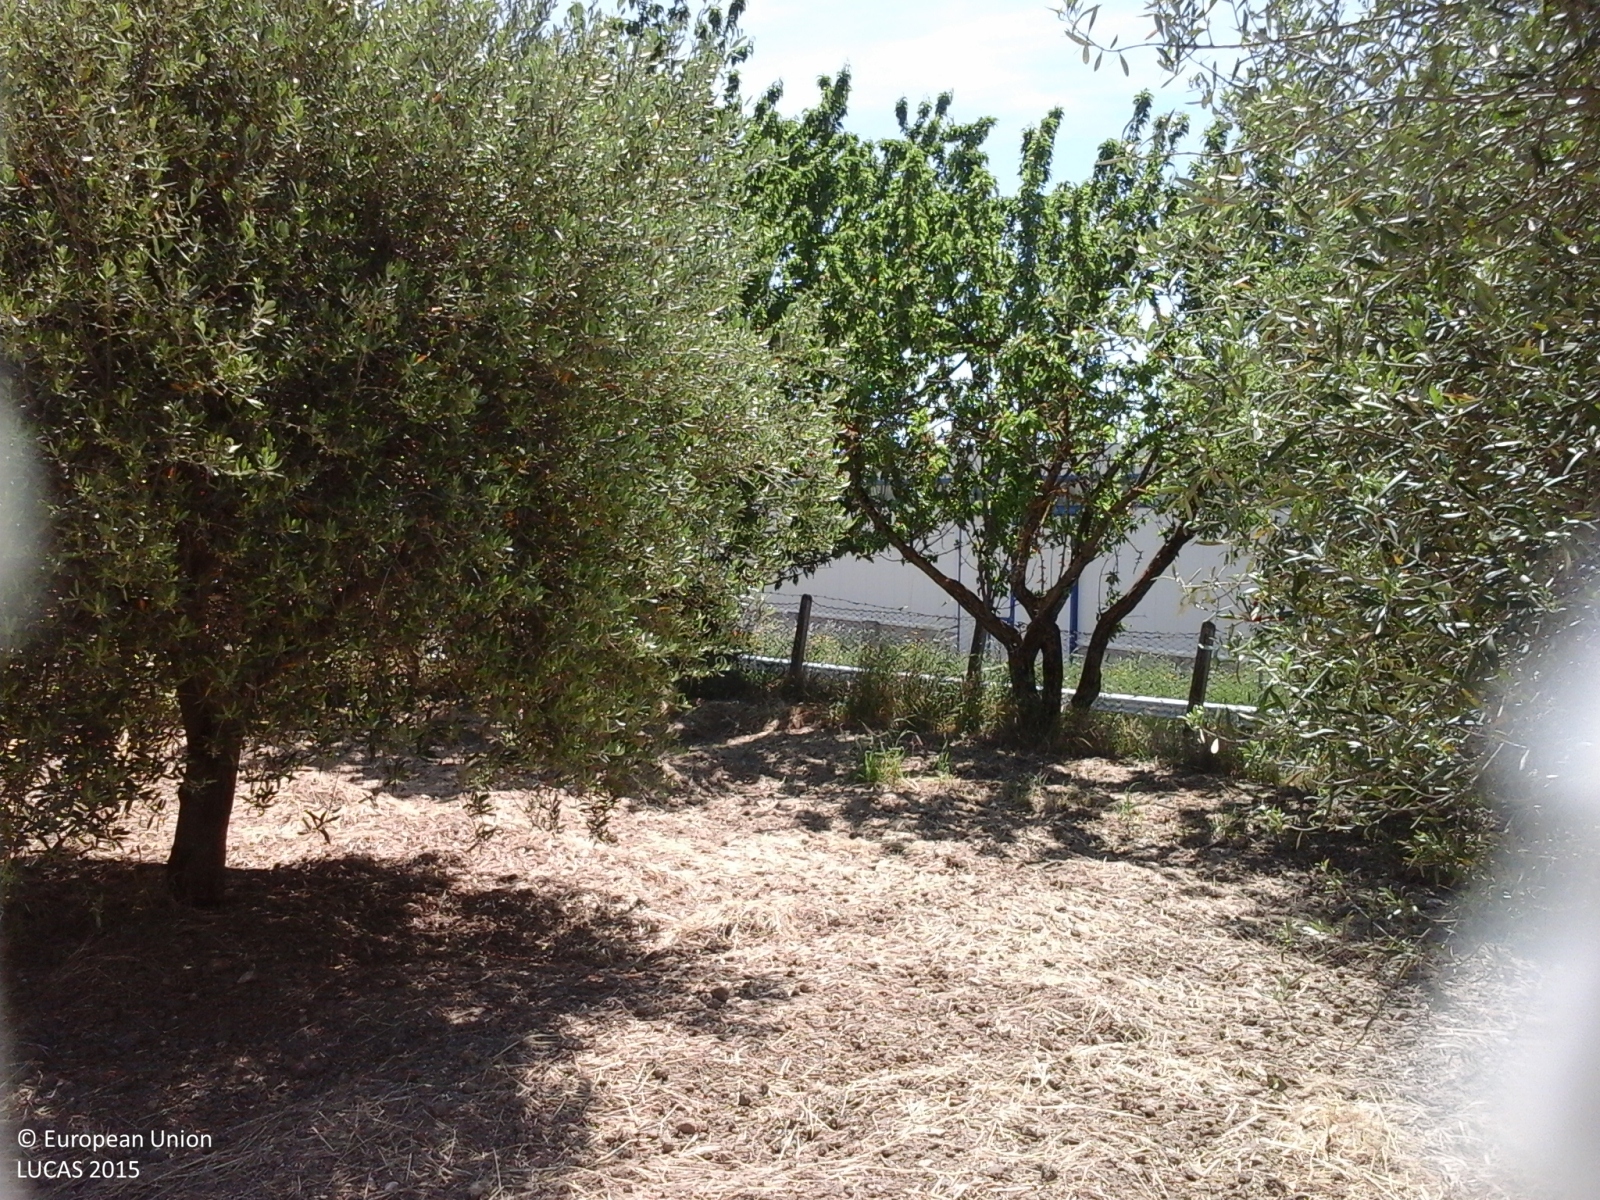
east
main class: Cropland
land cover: Olive groves
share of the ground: > 75 %
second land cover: Other bare soil
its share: > 75 %
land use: Agriculture (excluding fallow land and kitchen gardens)
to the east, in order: Olive groves; Other bare soil; Fences; Other bare soil; Fences; Grass margins; Paved roads, cycling and walking lanes; Fences; Grassland without tree/shrub cover; Artificial constructions in urban areas; Dry pulses; Lines of trees; Dry pulses
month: May
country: IT
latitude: 37.4641
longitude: 13.9837
